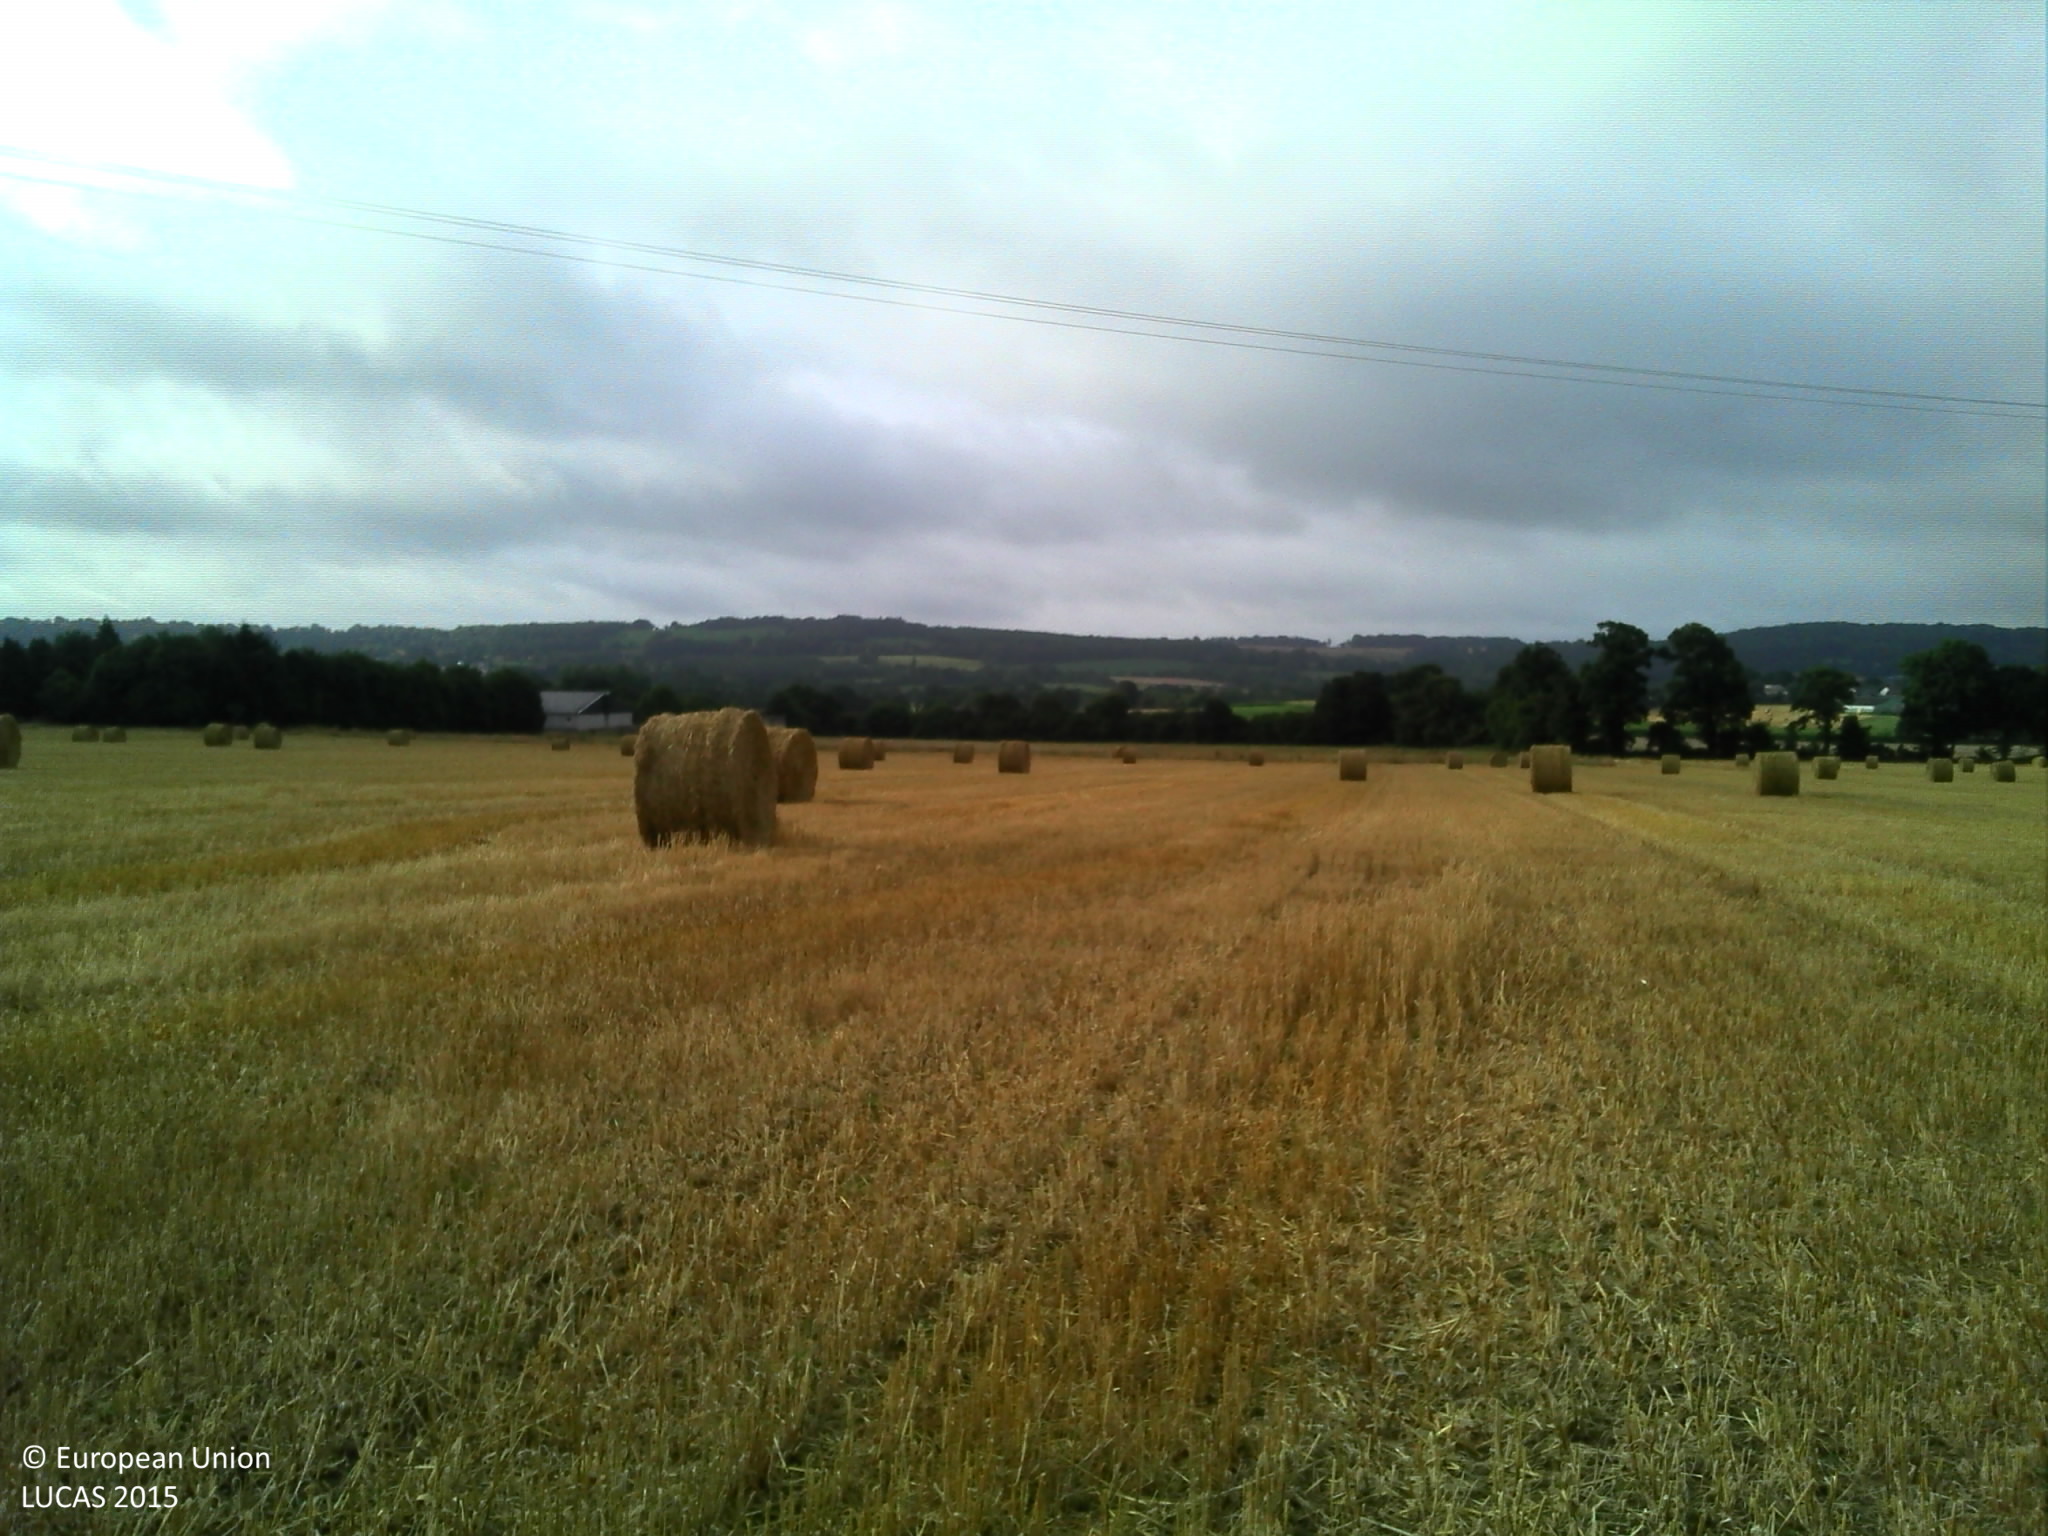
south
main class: Cropland
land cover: Common wheat
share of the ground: > 75 %
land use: Agriculture (excluding fallow land and kitchen gardens)
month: August
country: FR
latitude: 48.2824
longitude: -3.0474
